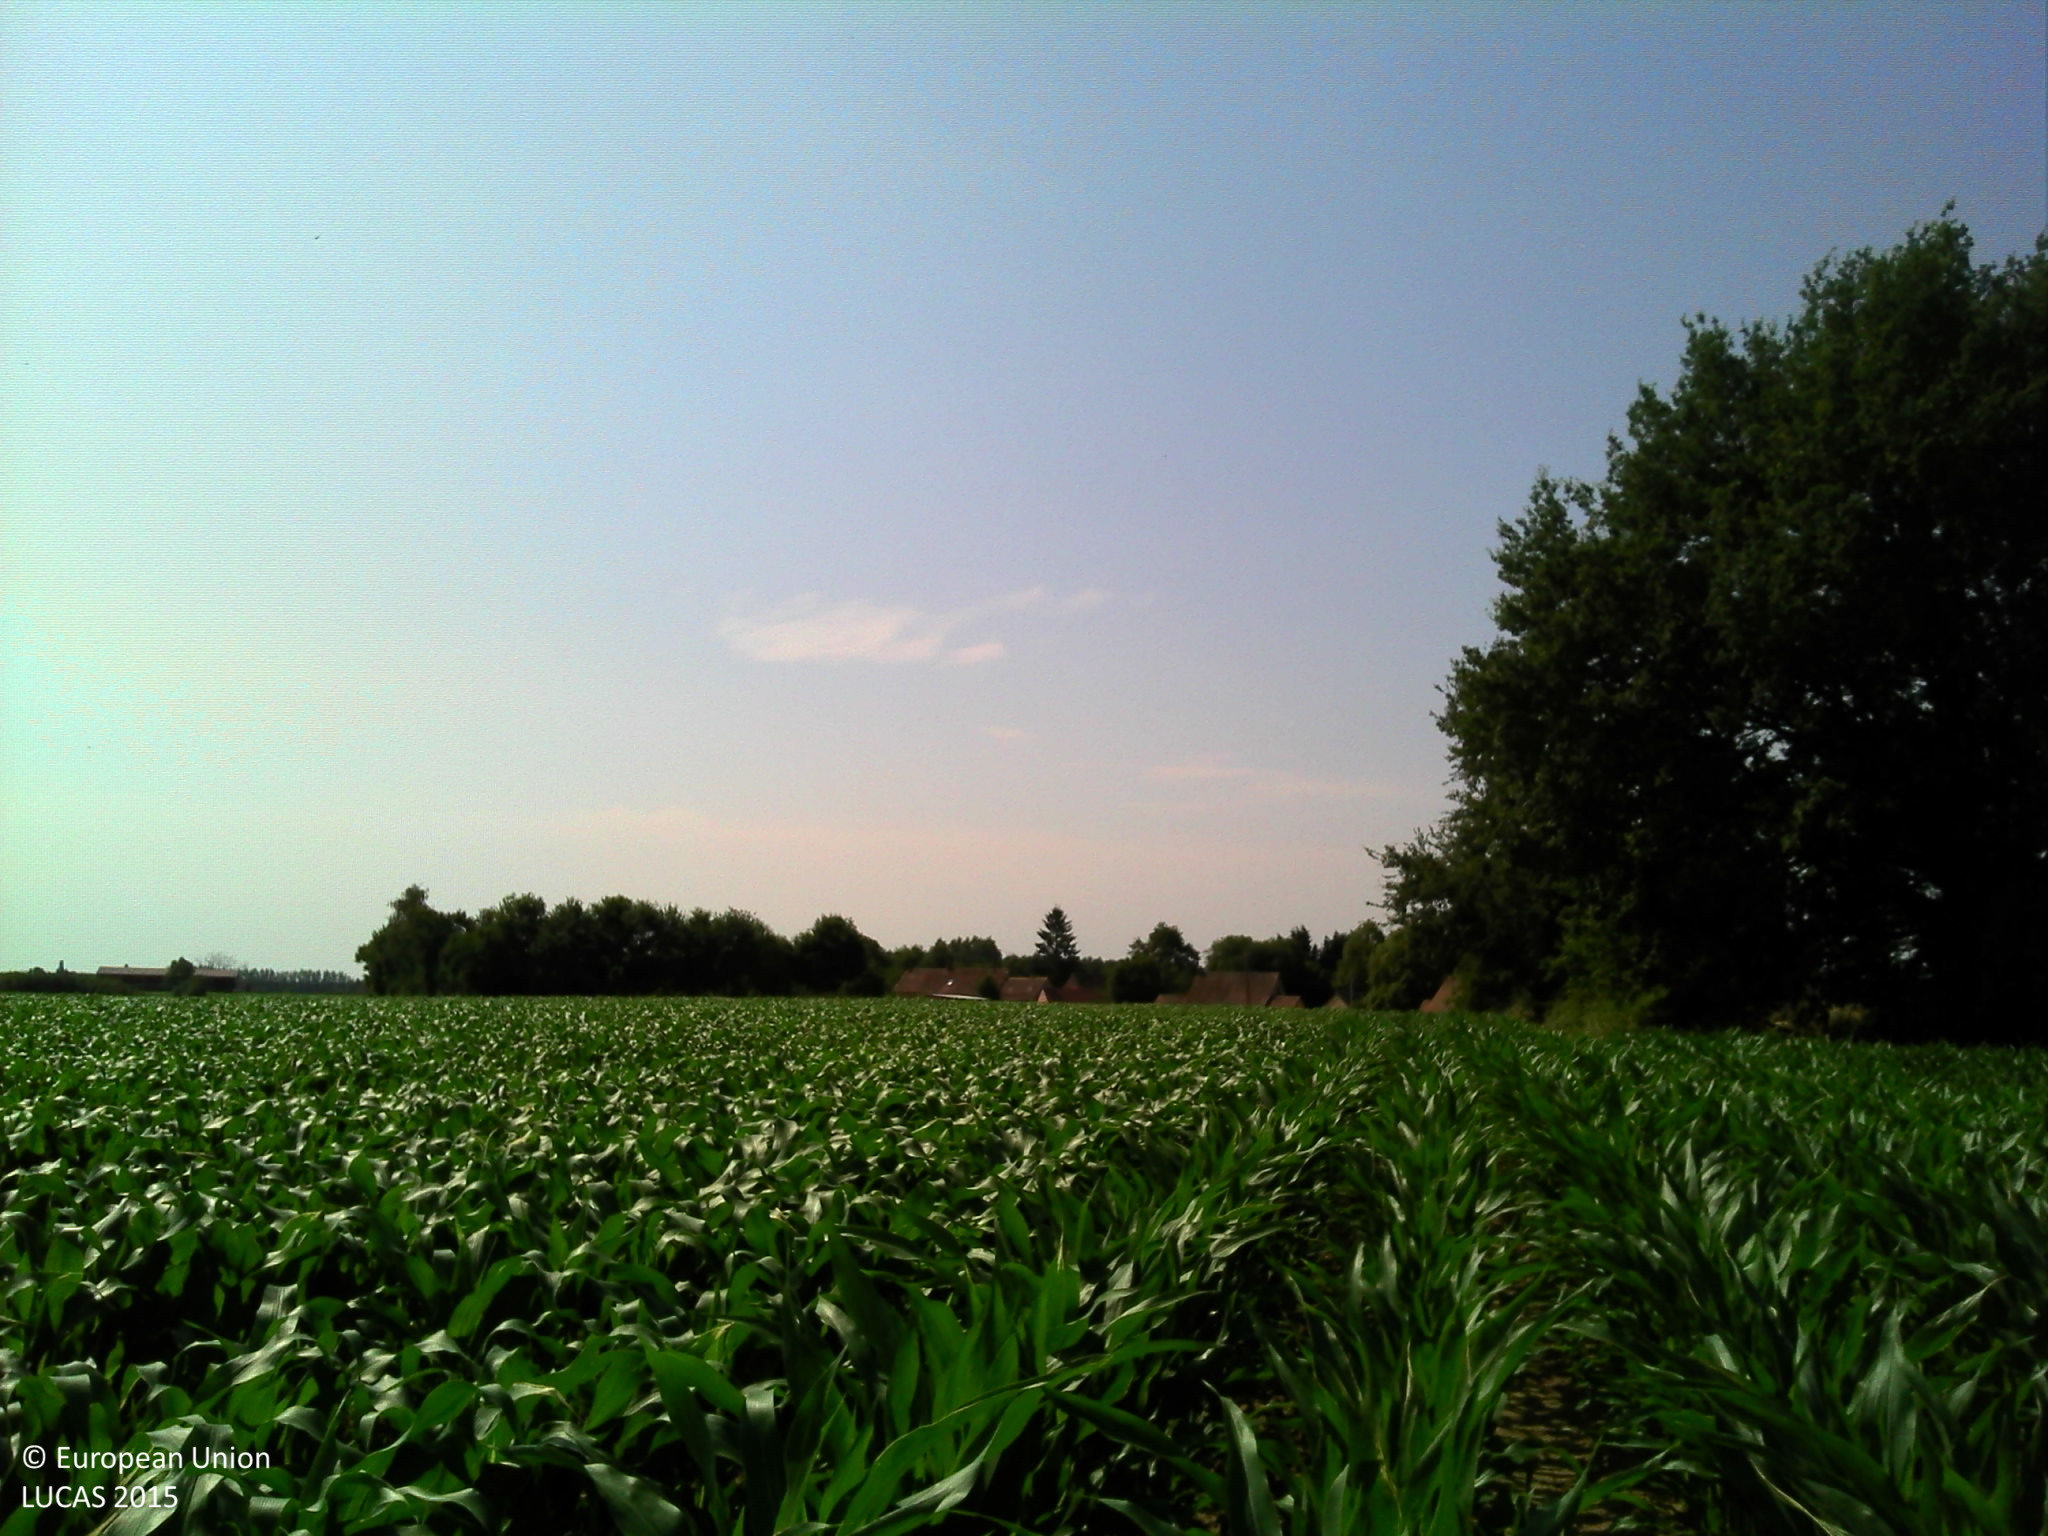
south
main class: Cropland
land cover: Maize
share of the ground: > 75 %
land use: Agriculture (excluding fallow land and kitchen gardens)
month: July
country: FR
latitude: 47.8231
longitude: 0.2107
